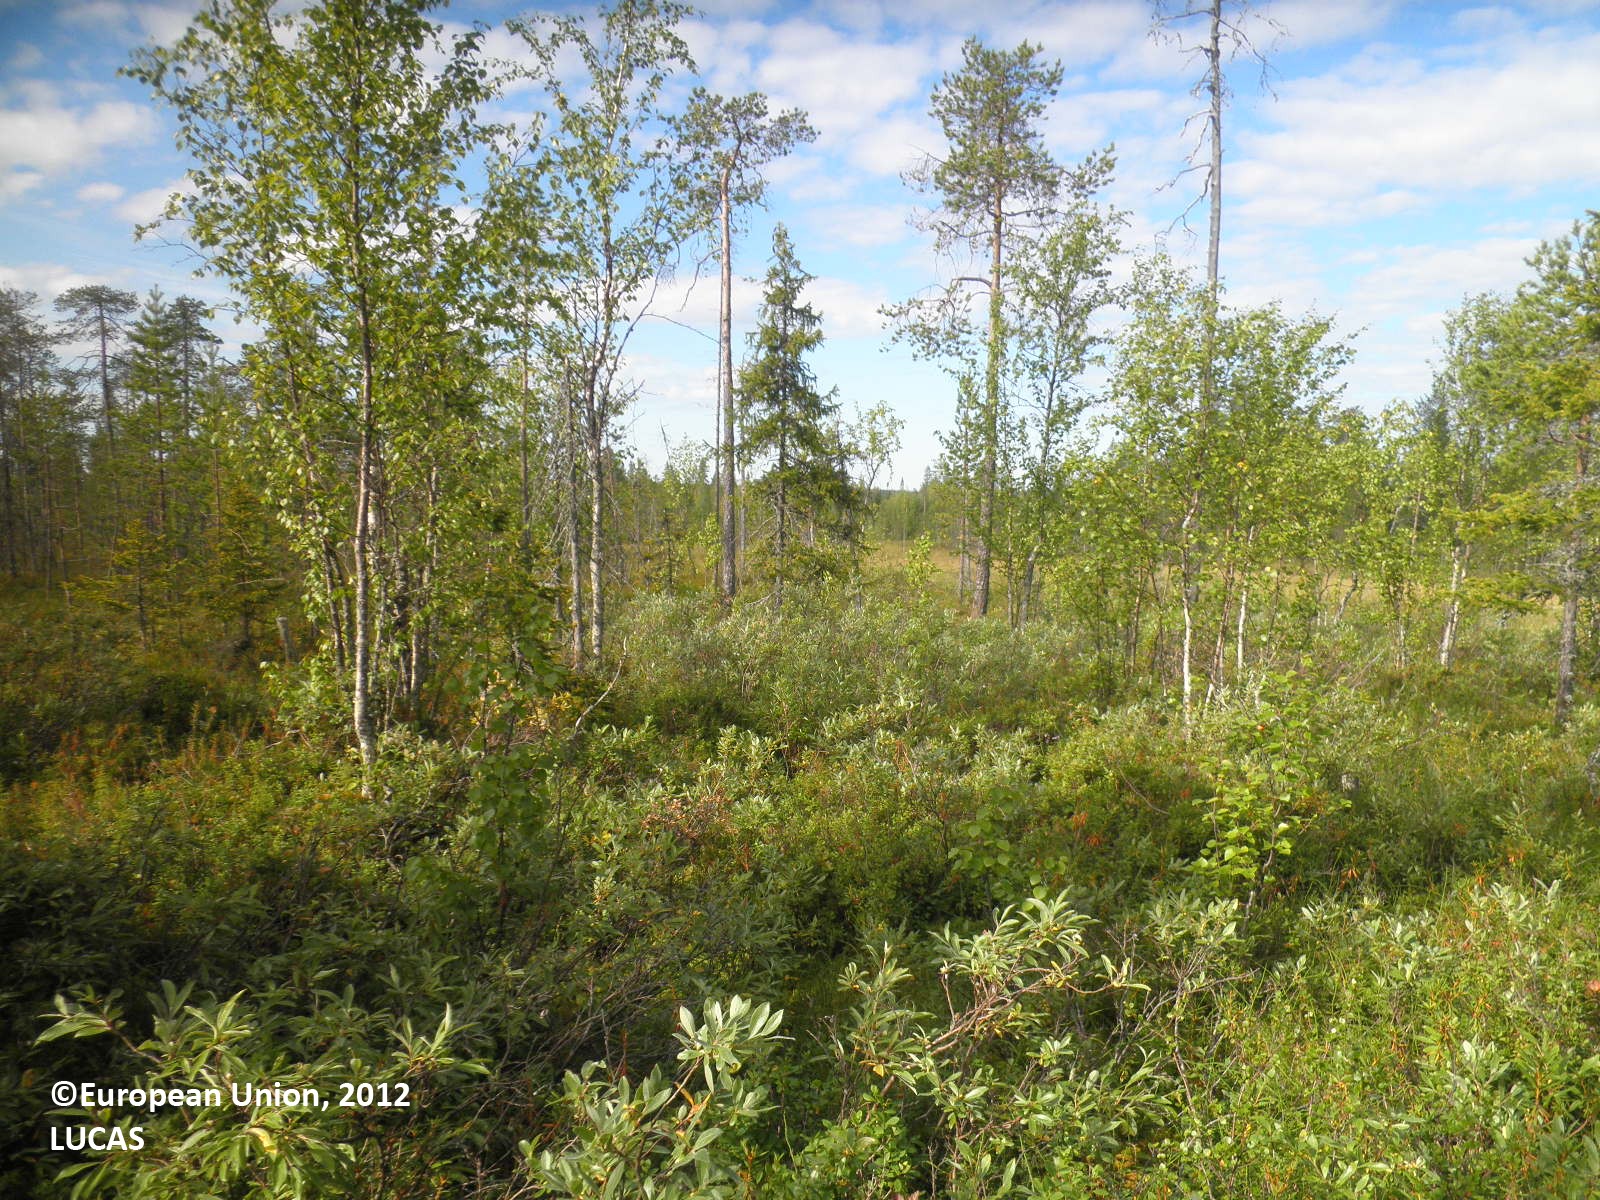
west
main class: Woodland
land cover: Pine dominated mixed woodland
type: boreal forest
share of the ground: 25 - 50 %
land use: Forestry
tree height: > 5 m
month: August
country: FI
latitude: 67.5038
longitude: 27.0653
